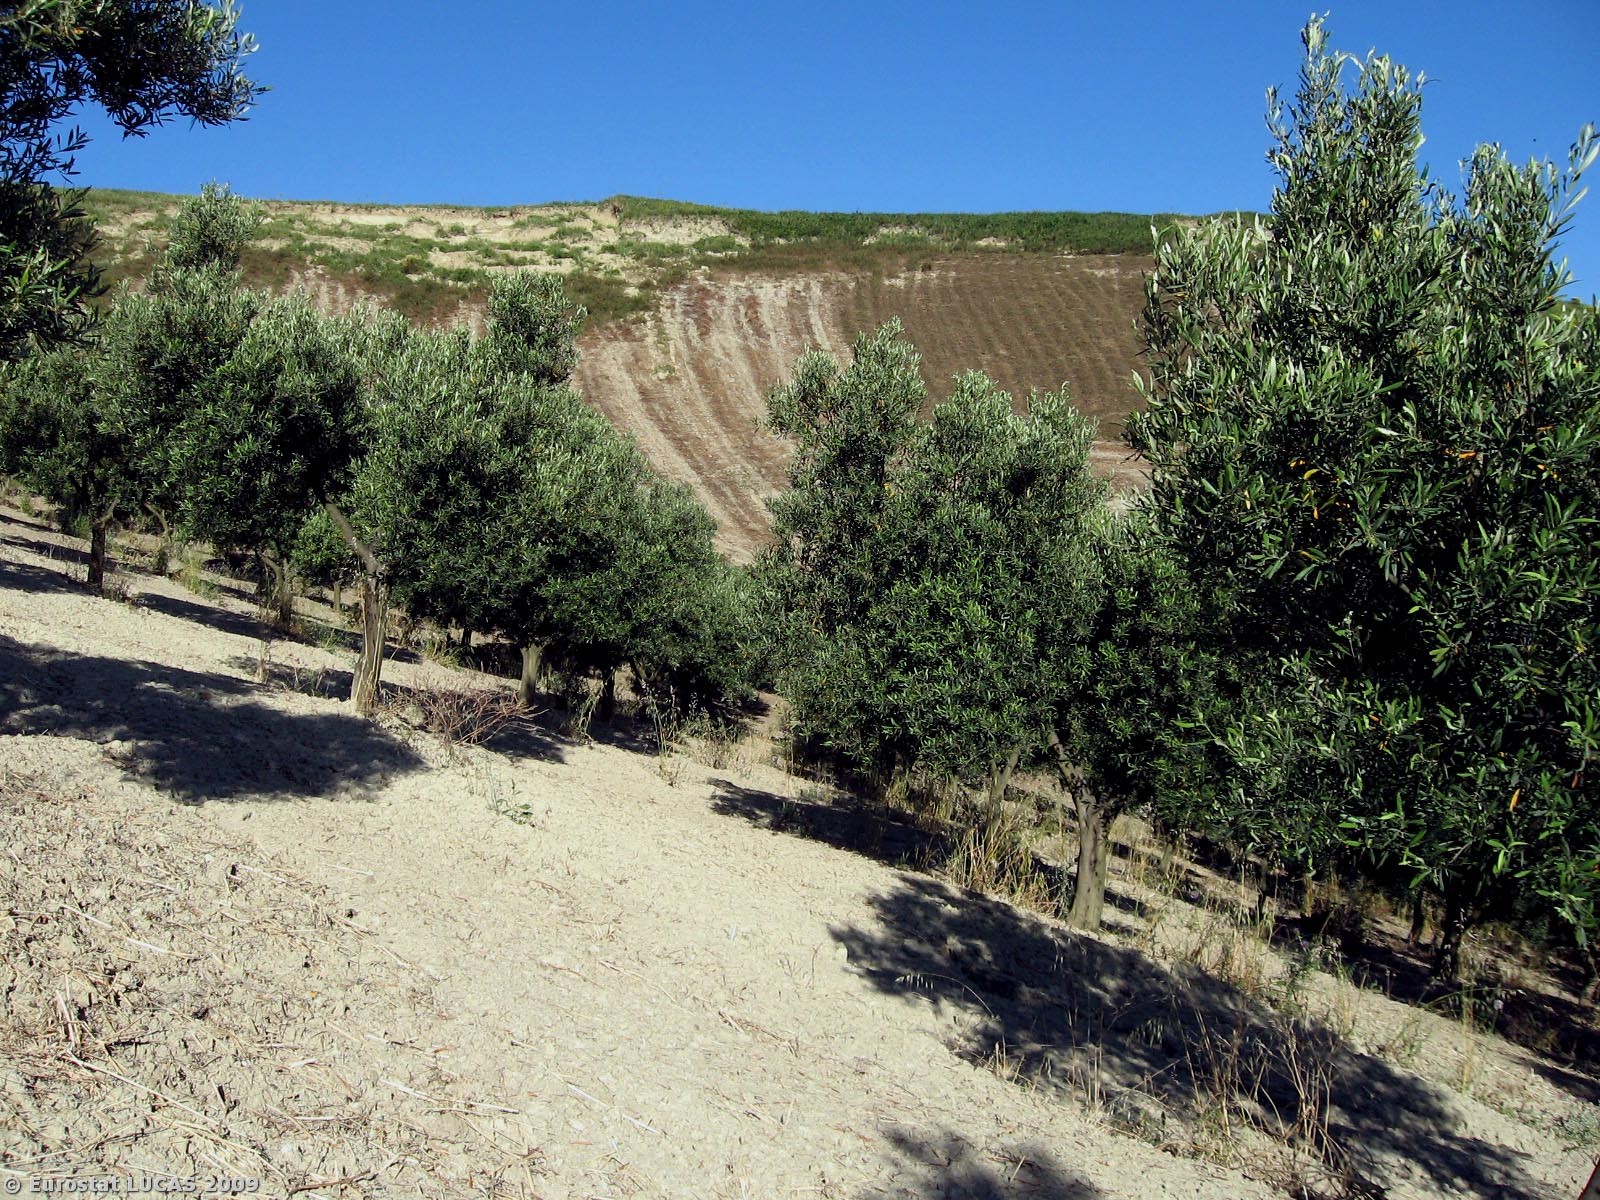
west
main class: Cropland
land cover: Olive groves
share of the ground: 25 - 50 %
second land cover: Bare land
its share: 50 - 75 %
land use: Agriculture (excluding fallow land and kitchen gardens)
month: June
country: IT
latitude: 38.8590
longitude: 16.4080
